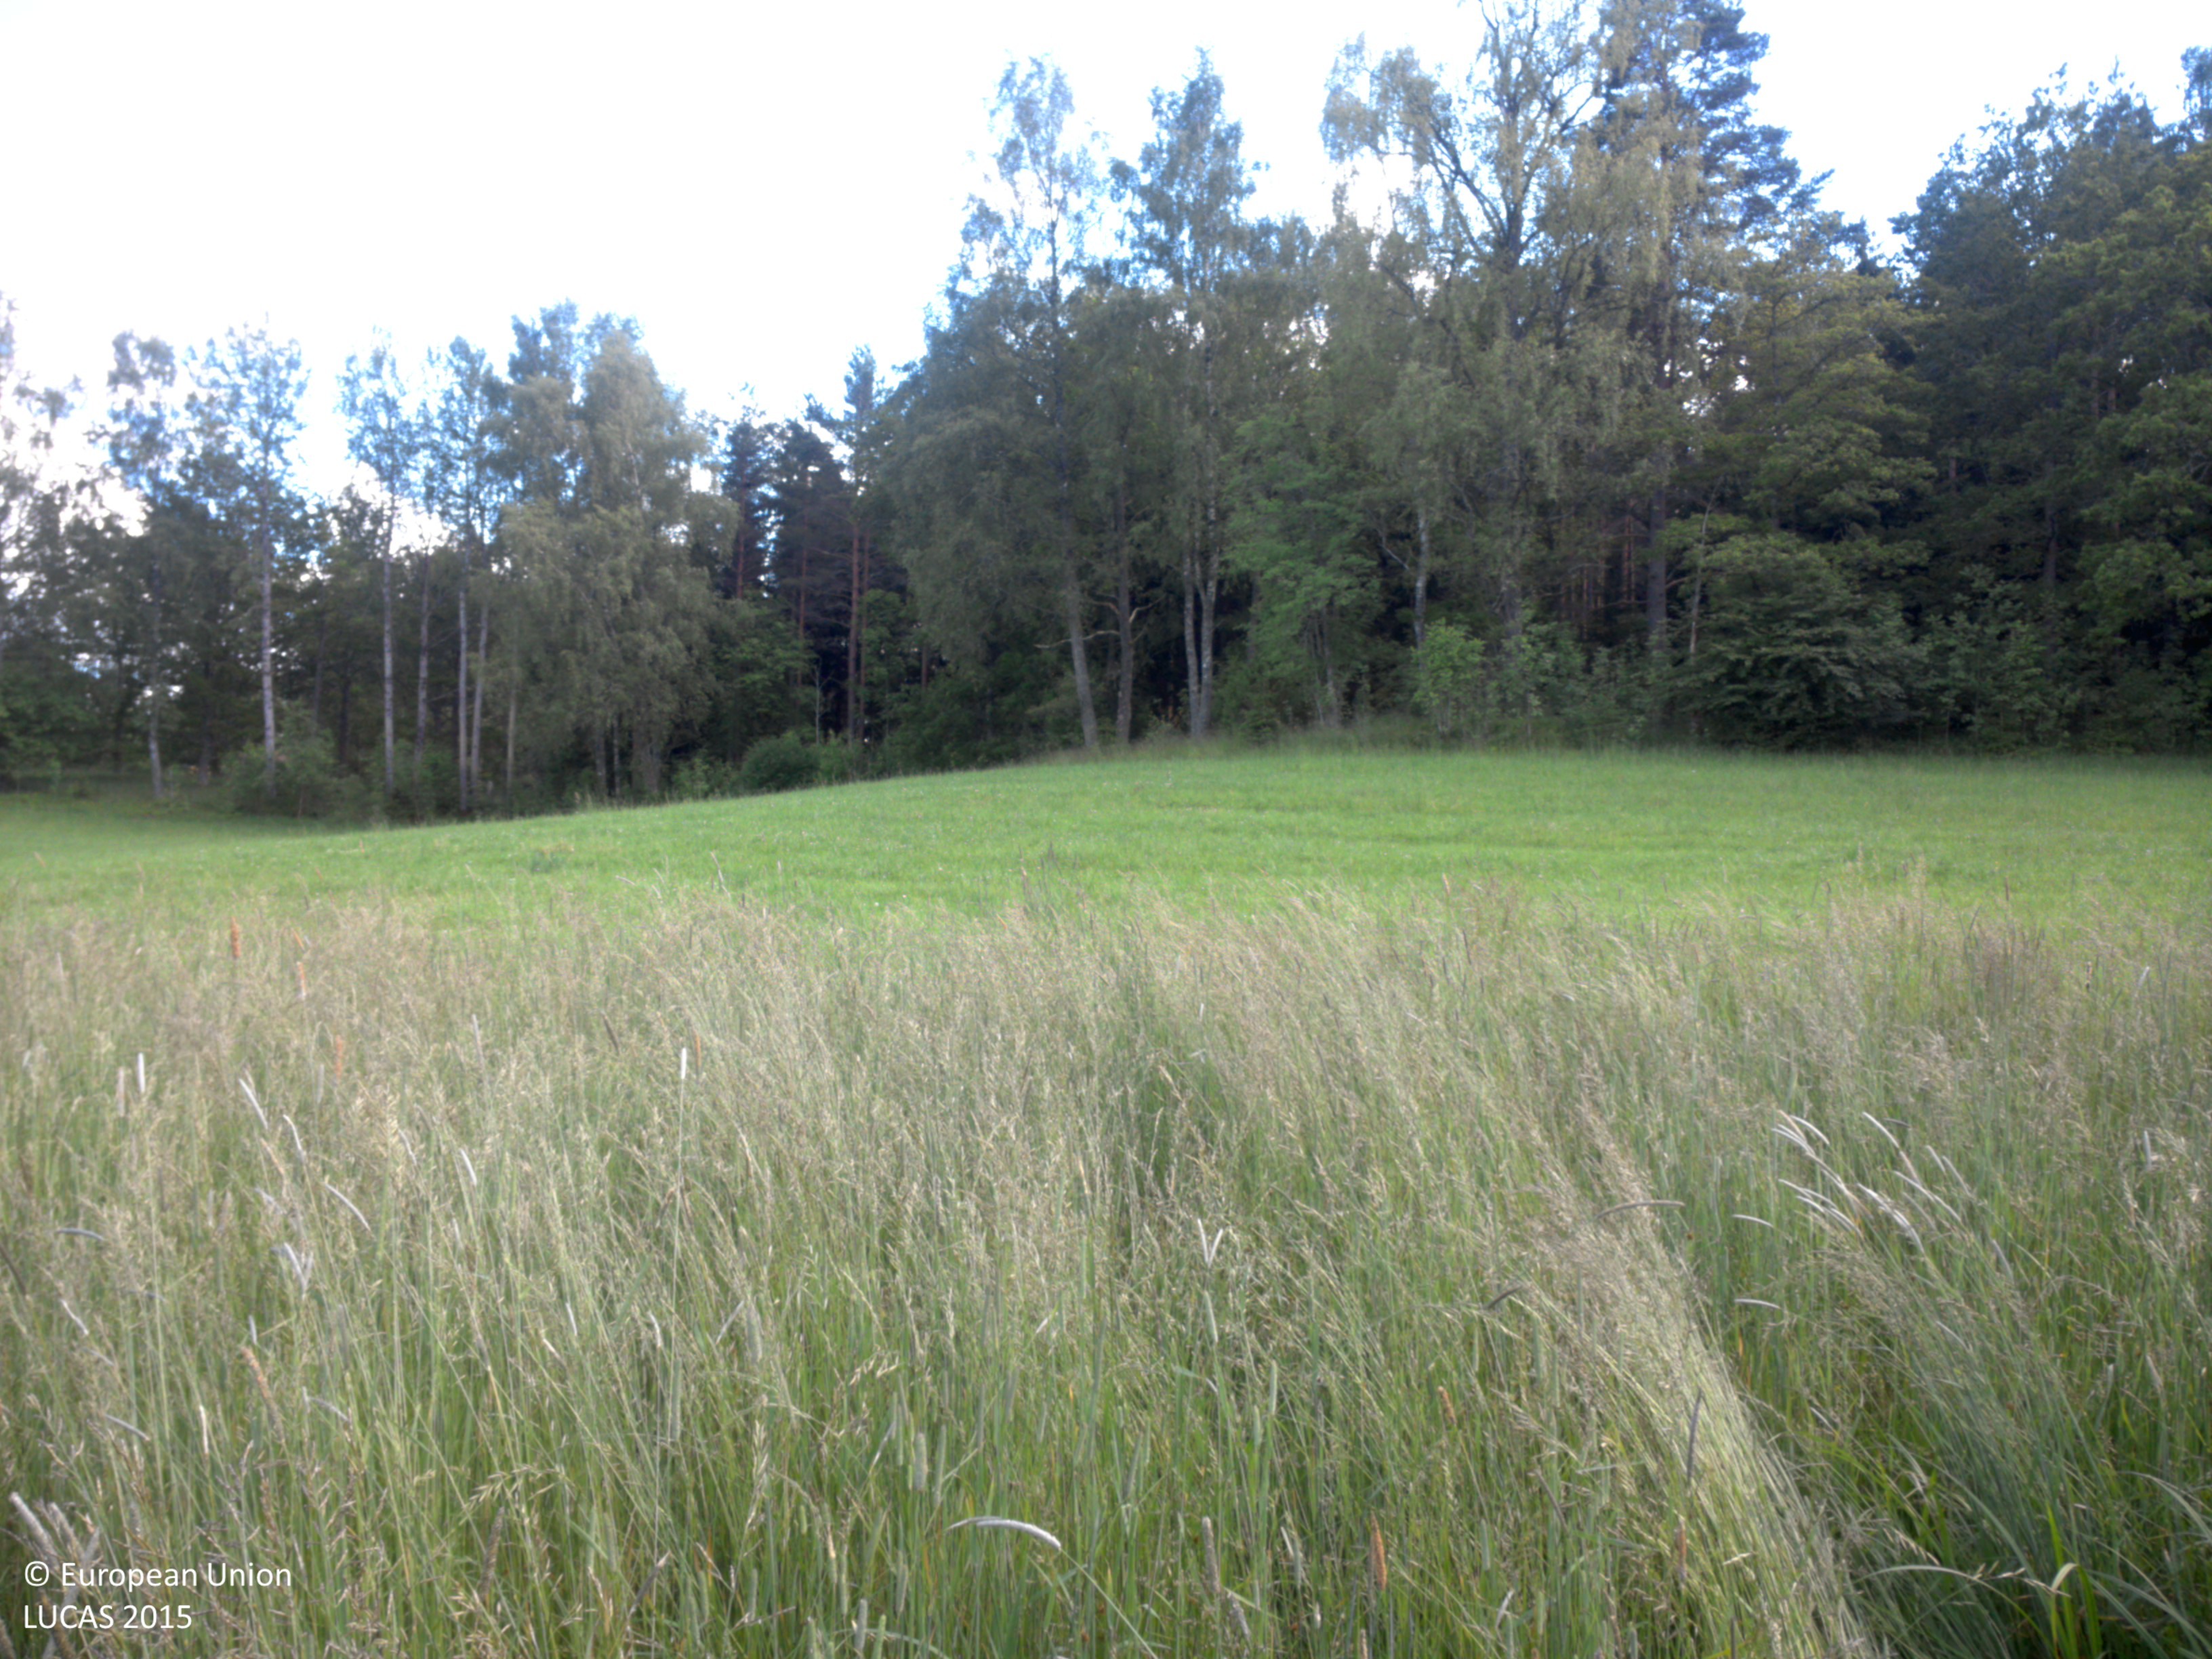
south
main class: Cropland
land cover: Mixed cereals for fodder
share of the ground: > 75 %
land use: Agriculture (excluding fallow land and kitchen gardens)
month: June
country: SE
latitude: 58.9561
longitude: 12.2723
